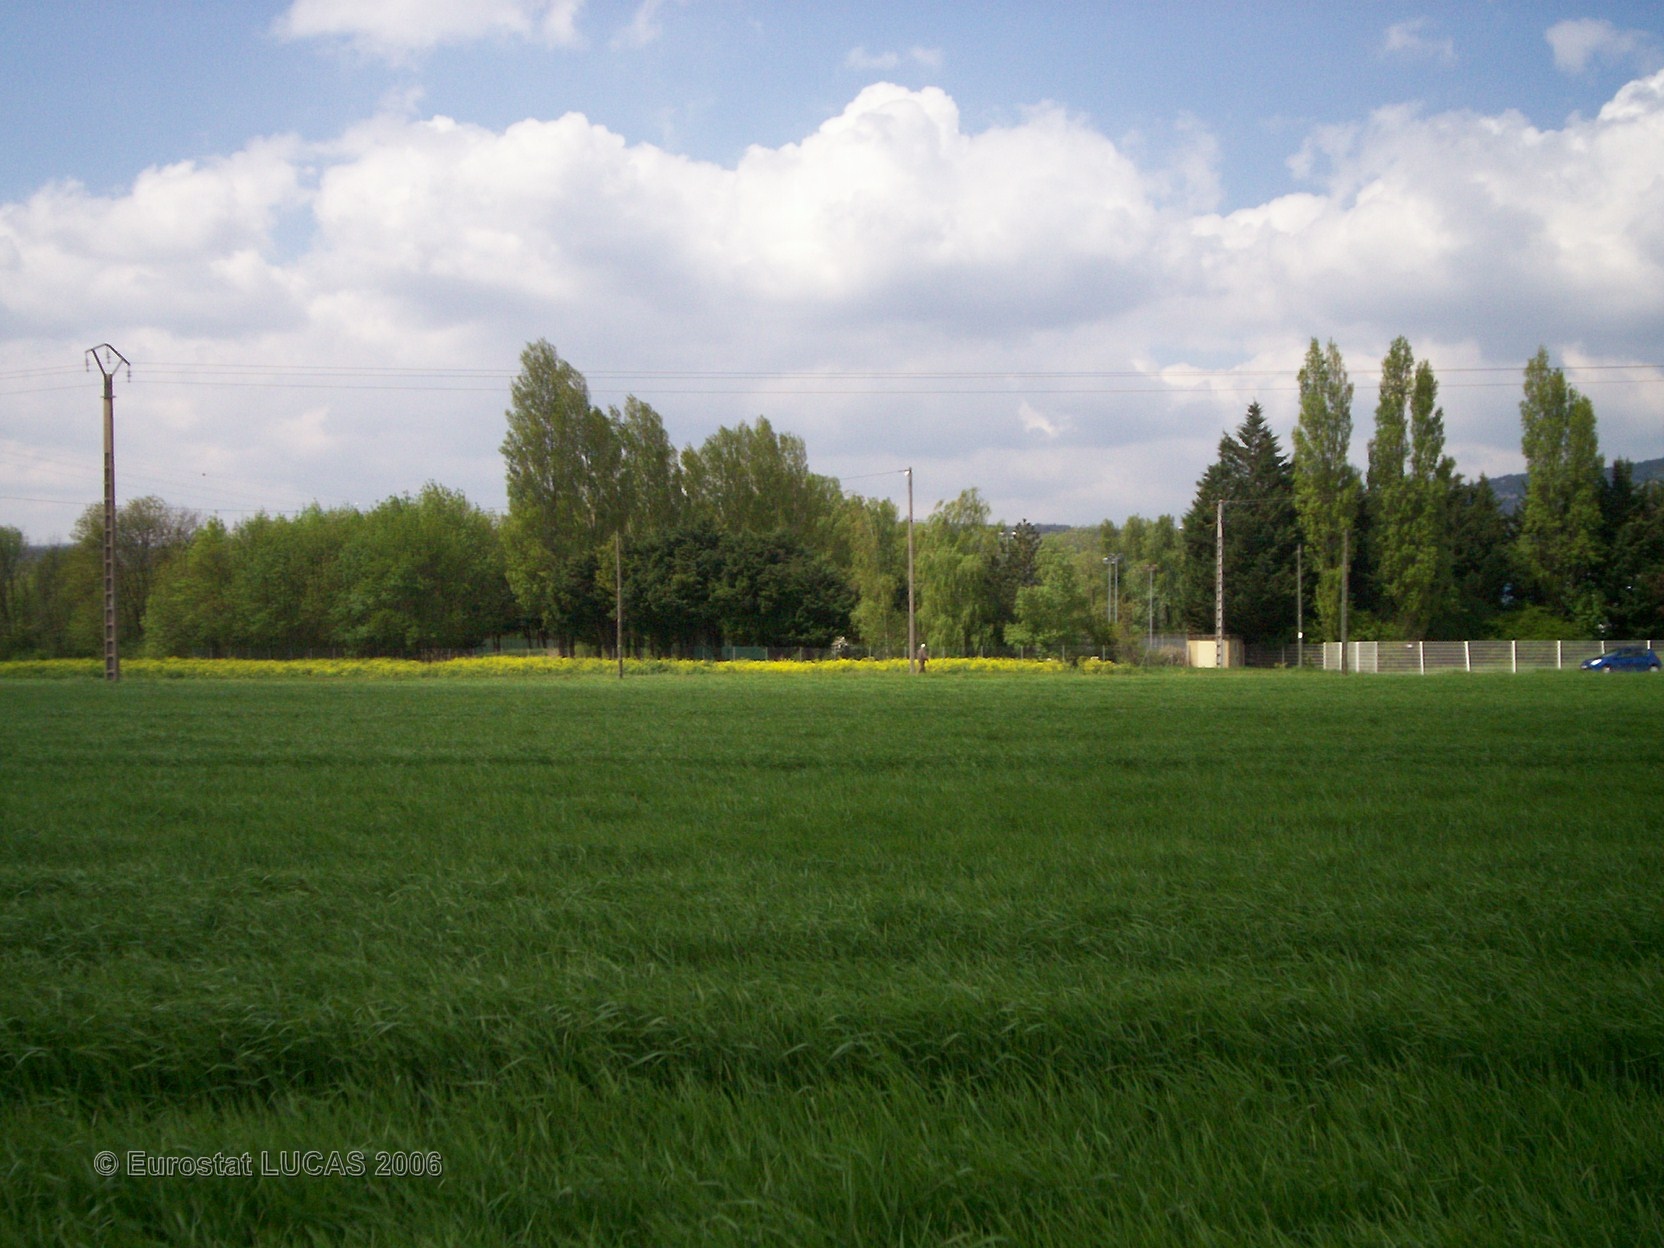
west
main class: Cropland
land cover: Barley
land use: Agriculture (excluding fallow land and kitchen gardens)
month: April
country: FR
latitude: 44.9105
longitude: 4.8760
